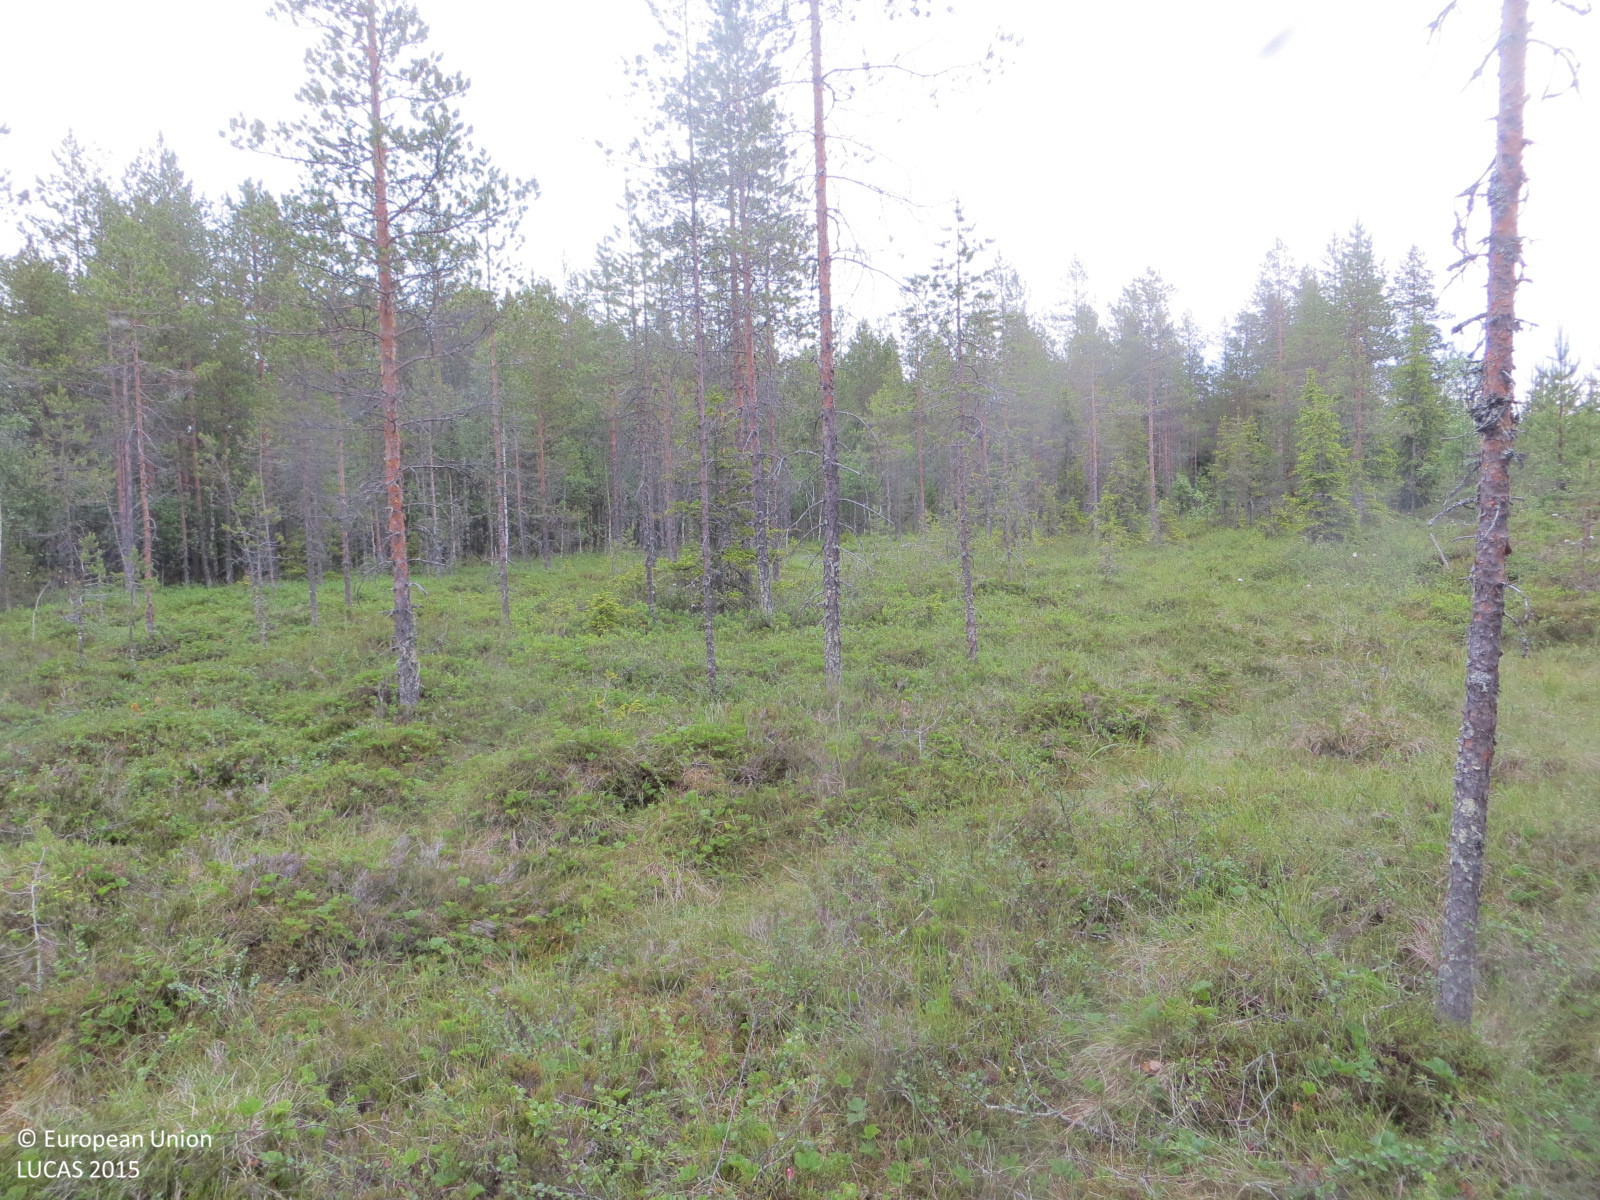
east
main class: Woodland
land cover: Pine dominated coniferous woodland
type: boreal forest
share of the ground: 25 - 50 %
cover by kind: shrubs 50 %, coniferous forest trees 40 %, lichens and mosses 10 %
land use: Forestry
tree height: > 5 m
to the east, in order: Pine dominated coniferous woodland; Pine dominated mixed woodland; Ditches and canals; Pine dominated mixed woodland; Ditches and canals; Pine dominated mixed woodland
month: June
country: FI
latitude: 65.4344
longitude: 26.1536
